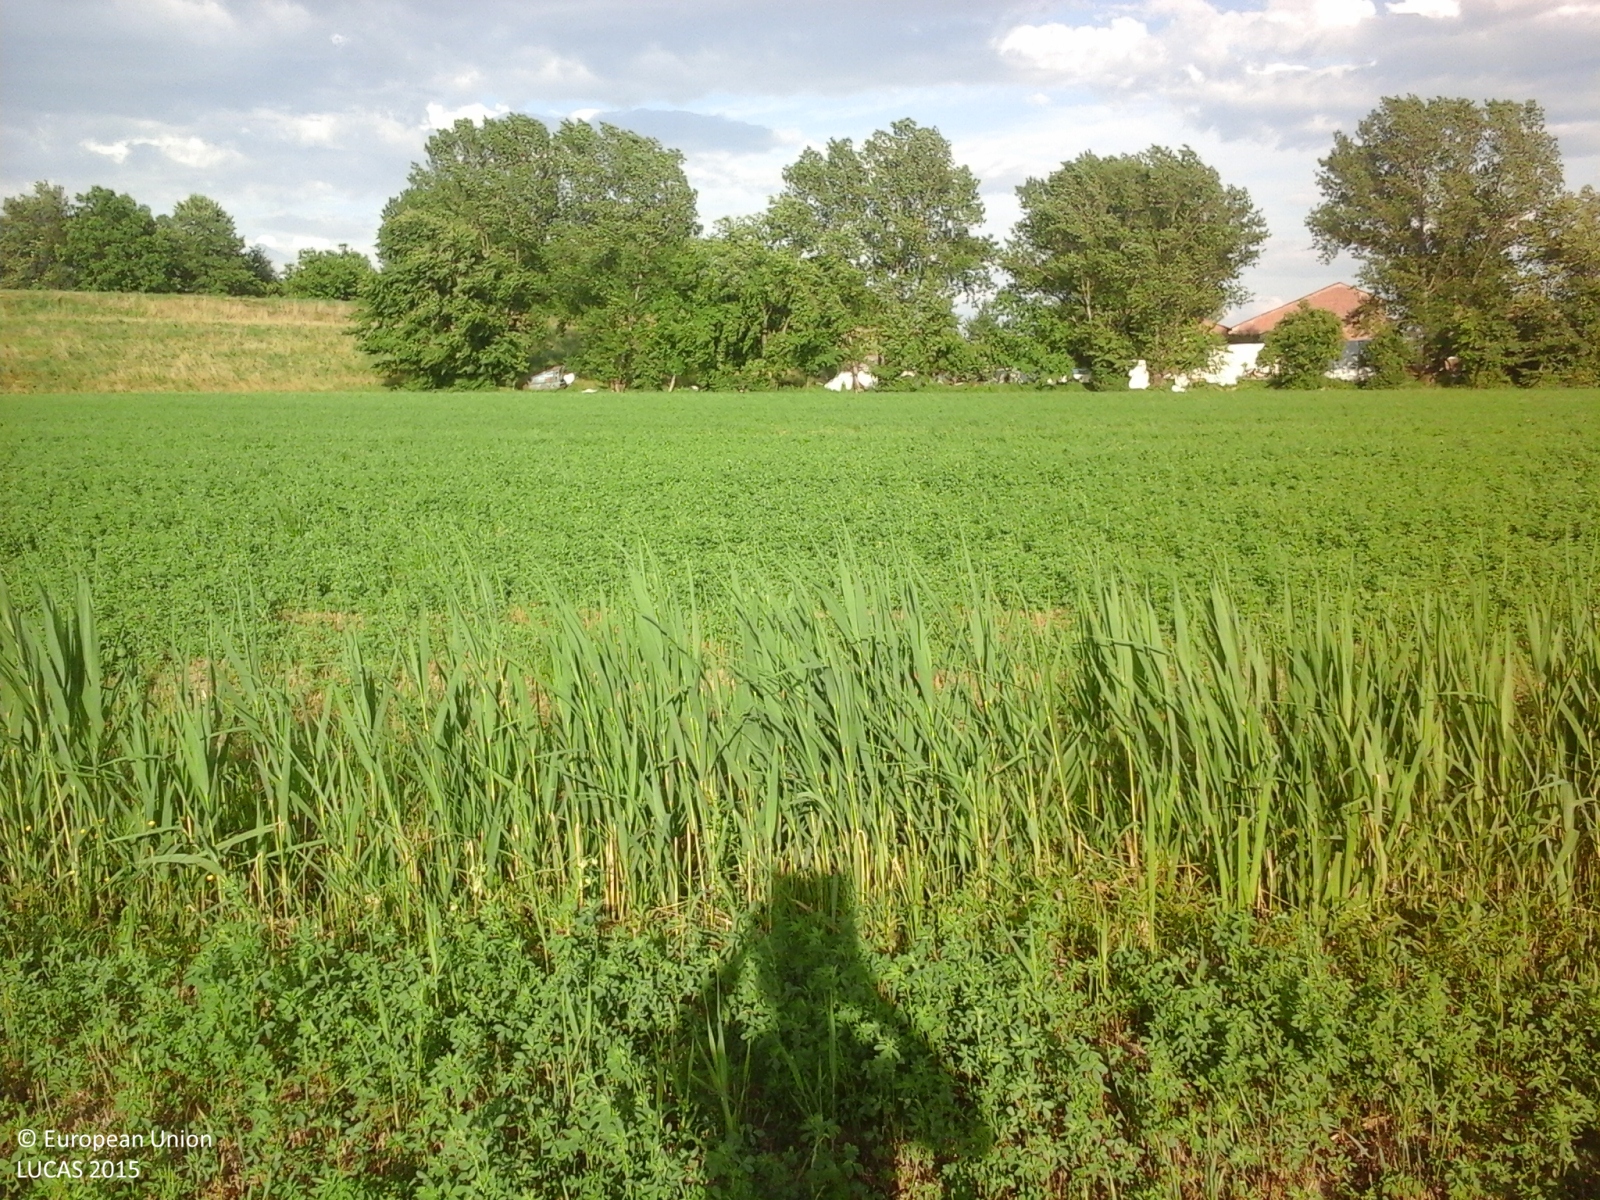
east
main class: Cropland
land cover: Lucerne
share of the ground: > 75 %
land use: Agriculture (excluding fallow land and kitchen gardens)
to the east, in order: Lucerne; Ditches and canals; Lucerne; Ditches and canals; Lucerne; Ditches and canals; Lucerne; Abandoned hedges; Ditches and canals; Abandoned hedges; Spontaneously vegetated surfaces; Tracks; Grassland without tree/shrub cover; Tracks; Grassland without tree/shrub cover; Broadleaved woodland; Inland fresh running water
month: May
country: IT
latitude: 45.1040
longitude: 10.9006
